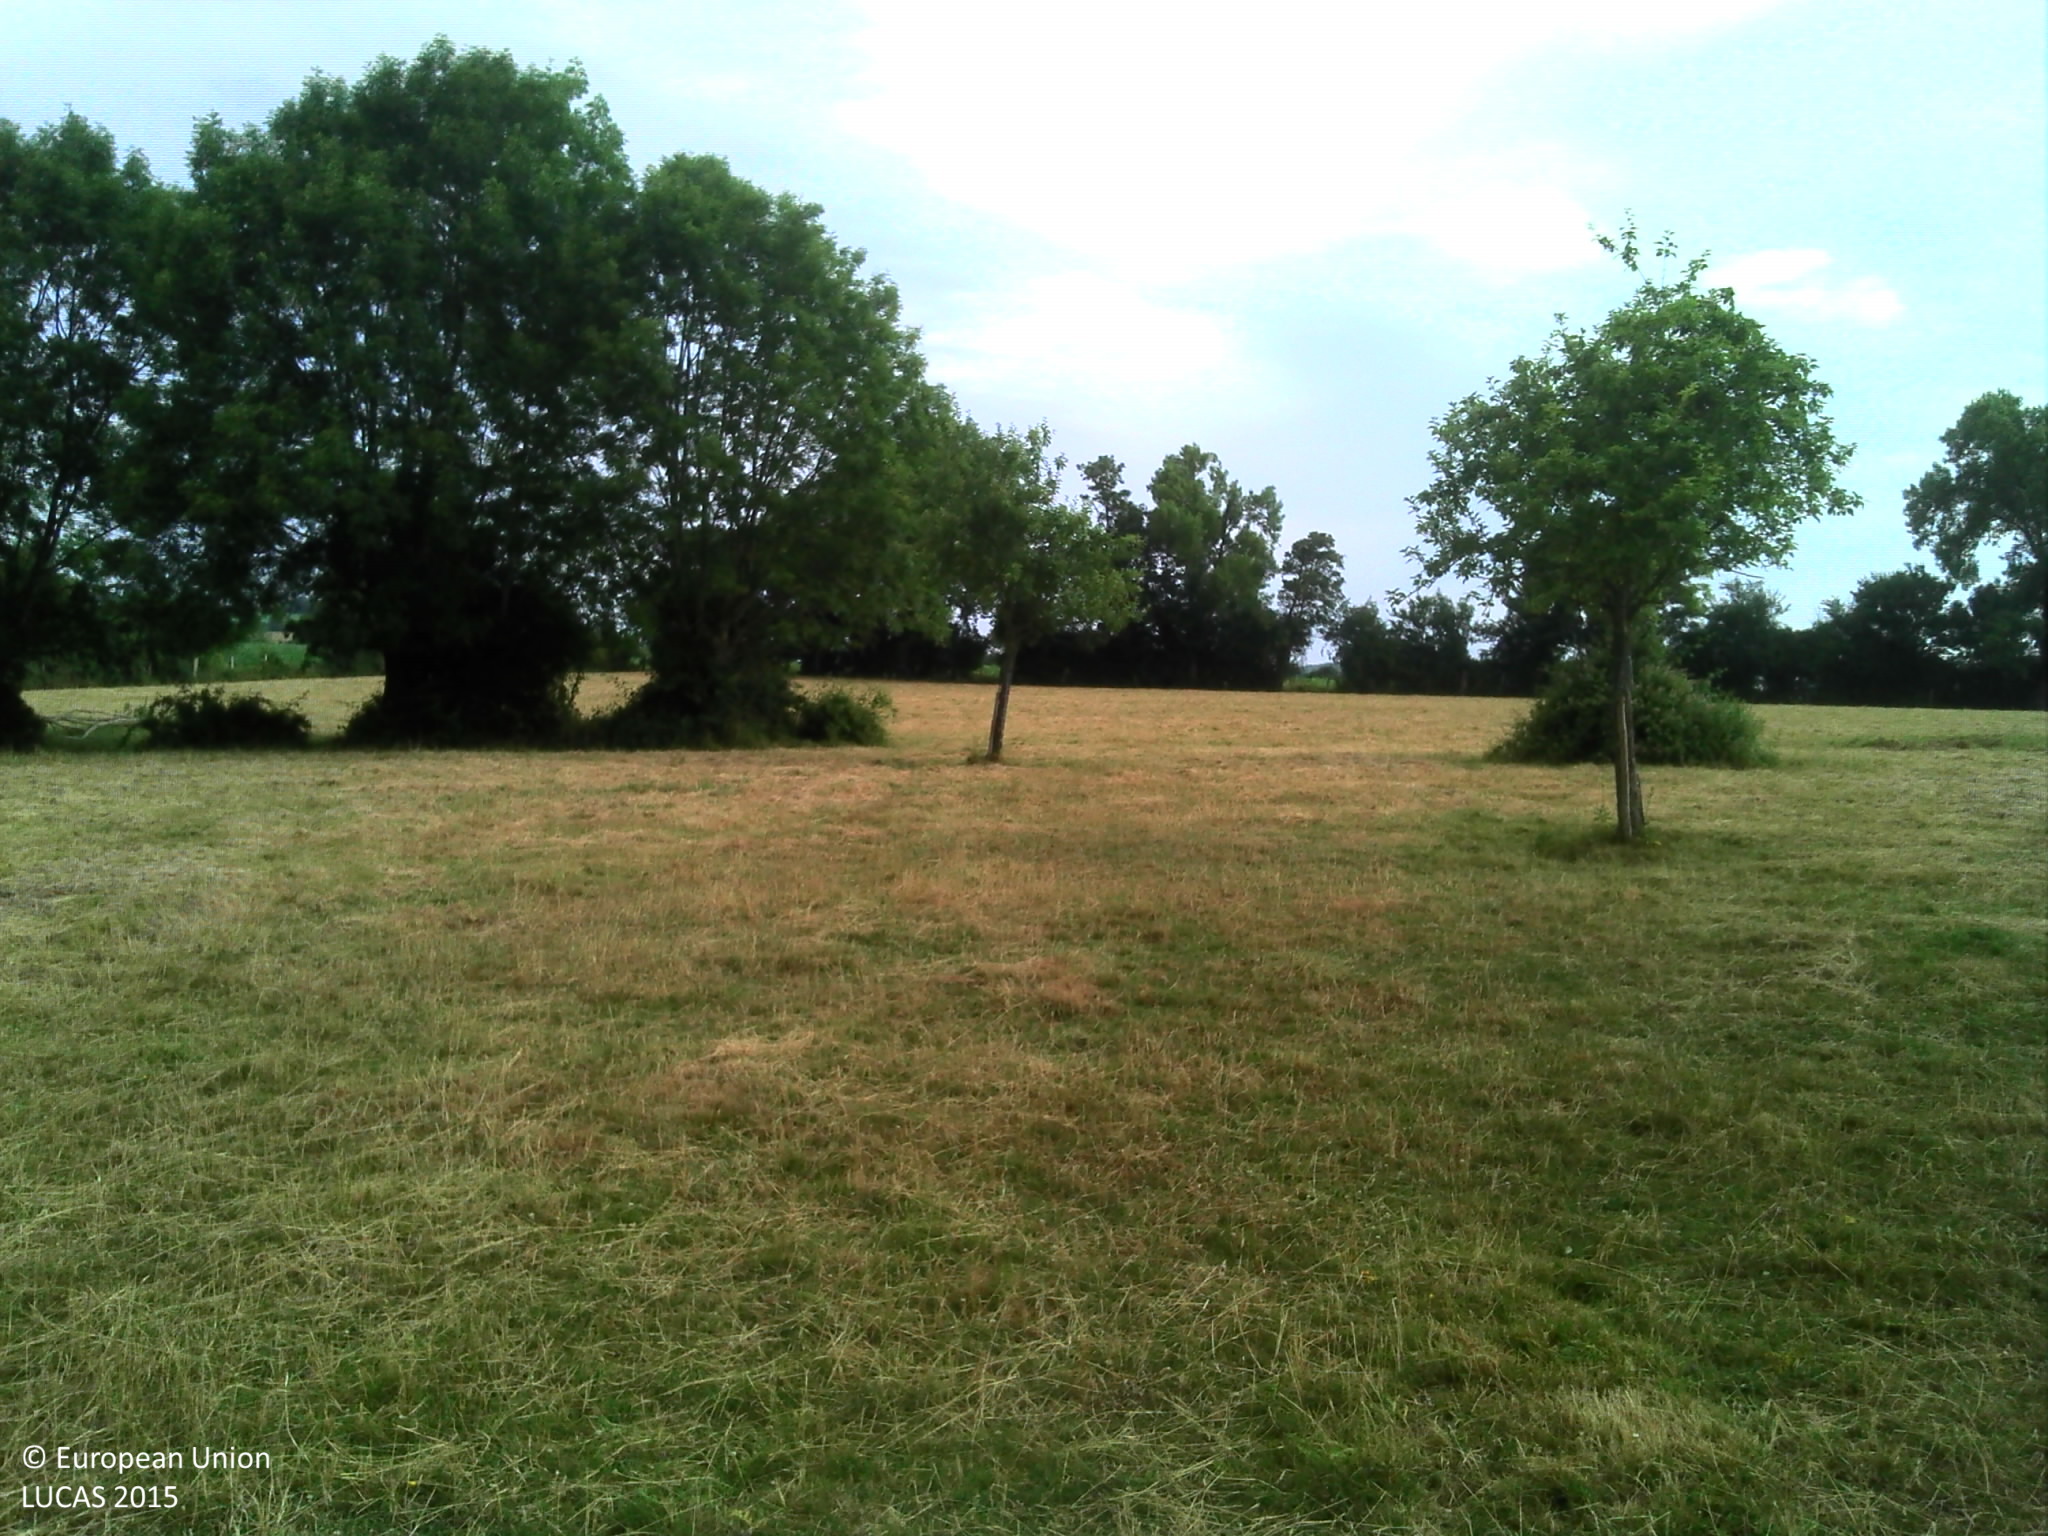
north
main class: Cropland
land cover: Apple fruit
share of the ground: 10 - 25 %
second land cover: Grassland without tree/shrub cover
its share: > 75 %
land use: Agriculture (excluding fallow land and kitchen gardens)
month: July
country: FR
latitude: 48.9499
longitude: 0.0425
